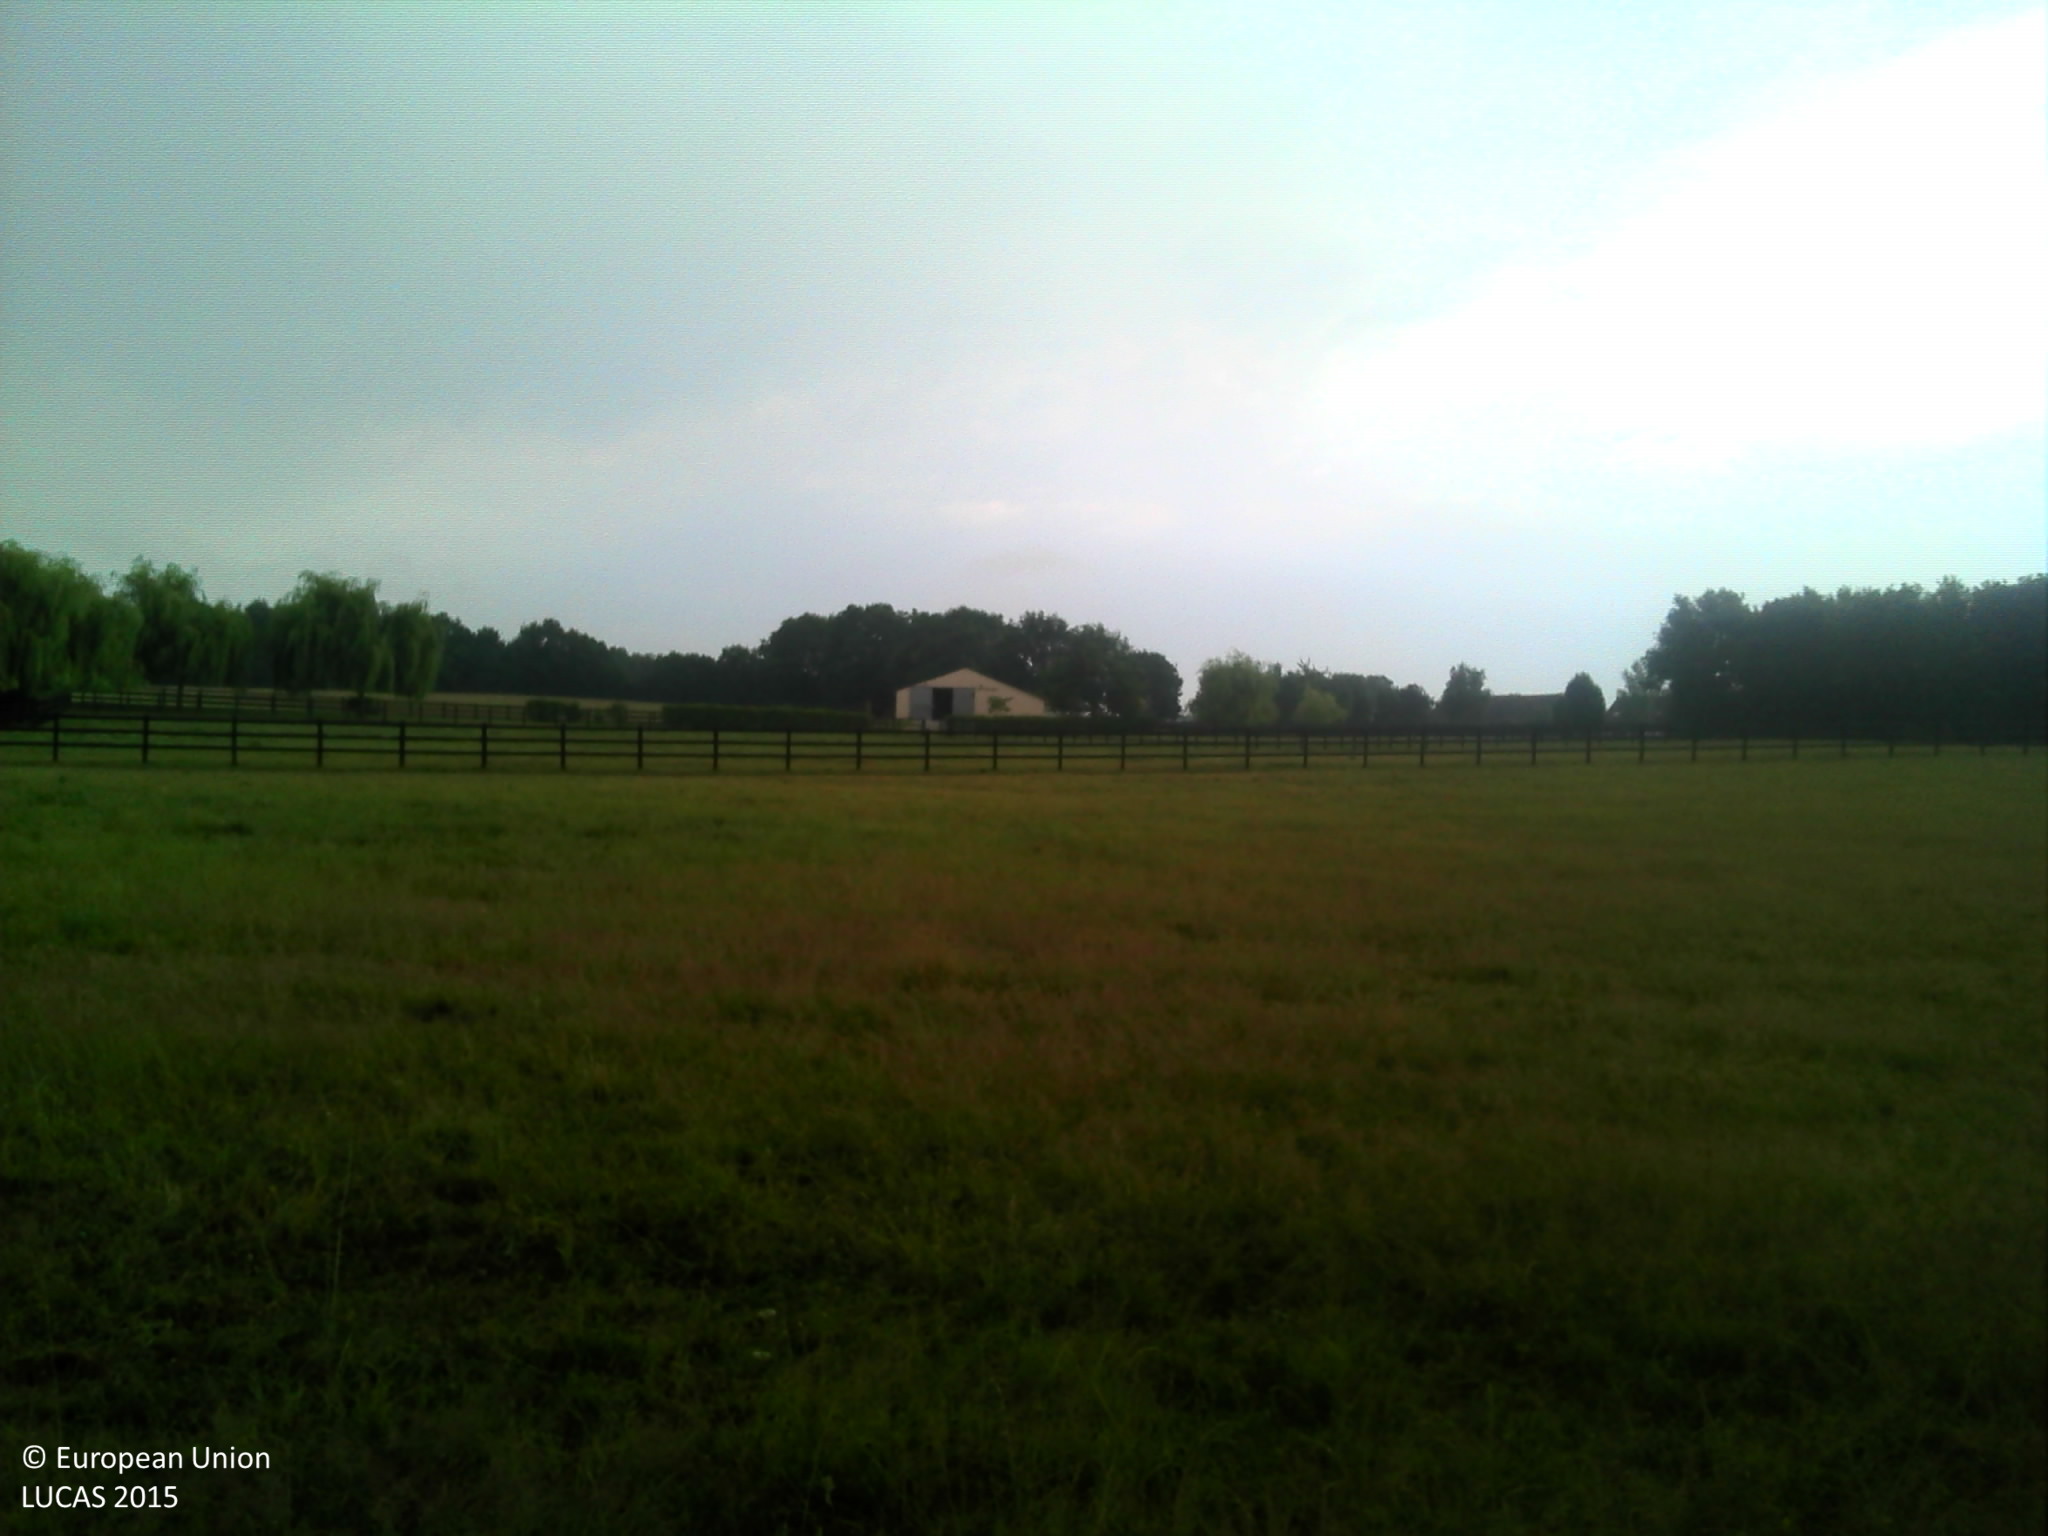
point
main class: Grassland
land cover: Grassland without tree/shrub cover
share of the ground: > 75 %
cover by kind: herbaceous plants 100 %
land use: Agriculture (excluding fallow land and kitchen gardens)
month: July
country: FR
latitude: 48.1433
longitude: 0.5554
